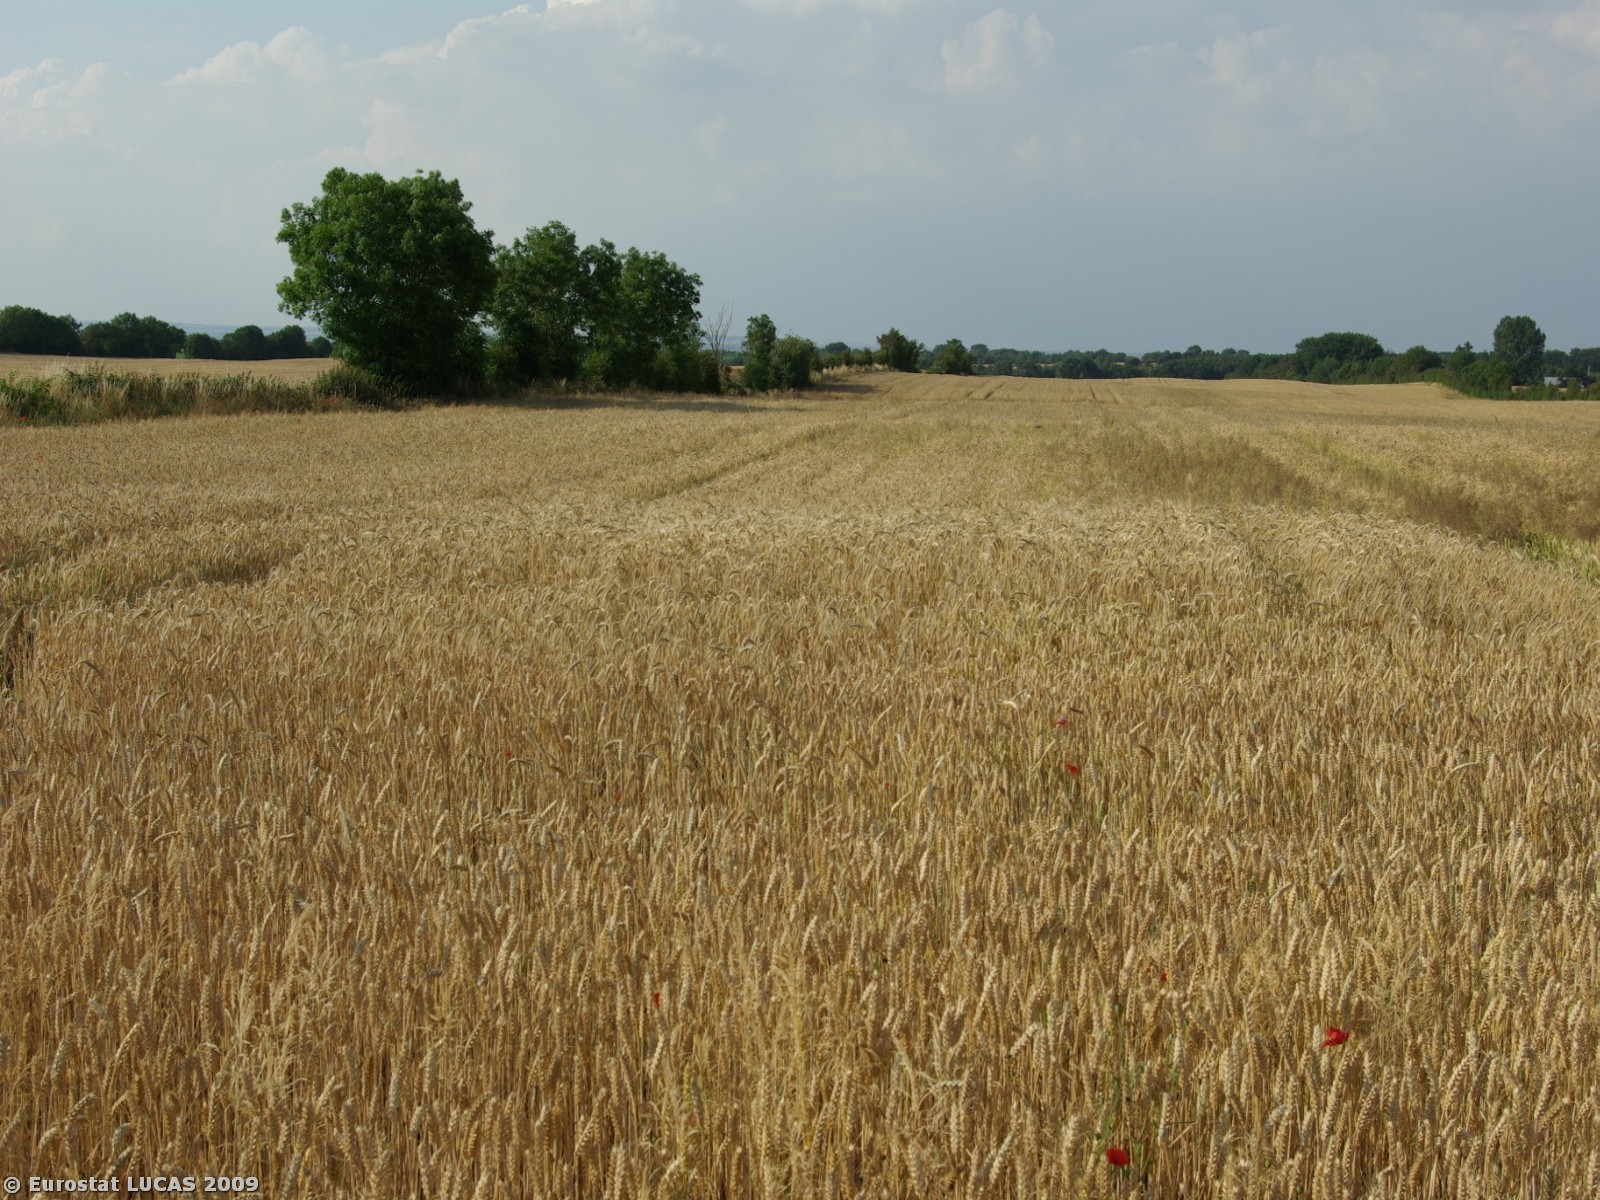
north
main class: Cropland
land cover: Common wheat
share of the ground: > 75 %
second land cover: Triticale
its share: 25 - 50 %
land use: Agriculture (excluding fallow land and kitchen gardens)
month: July
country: DK
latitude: 55.0550
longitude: 9.7028
